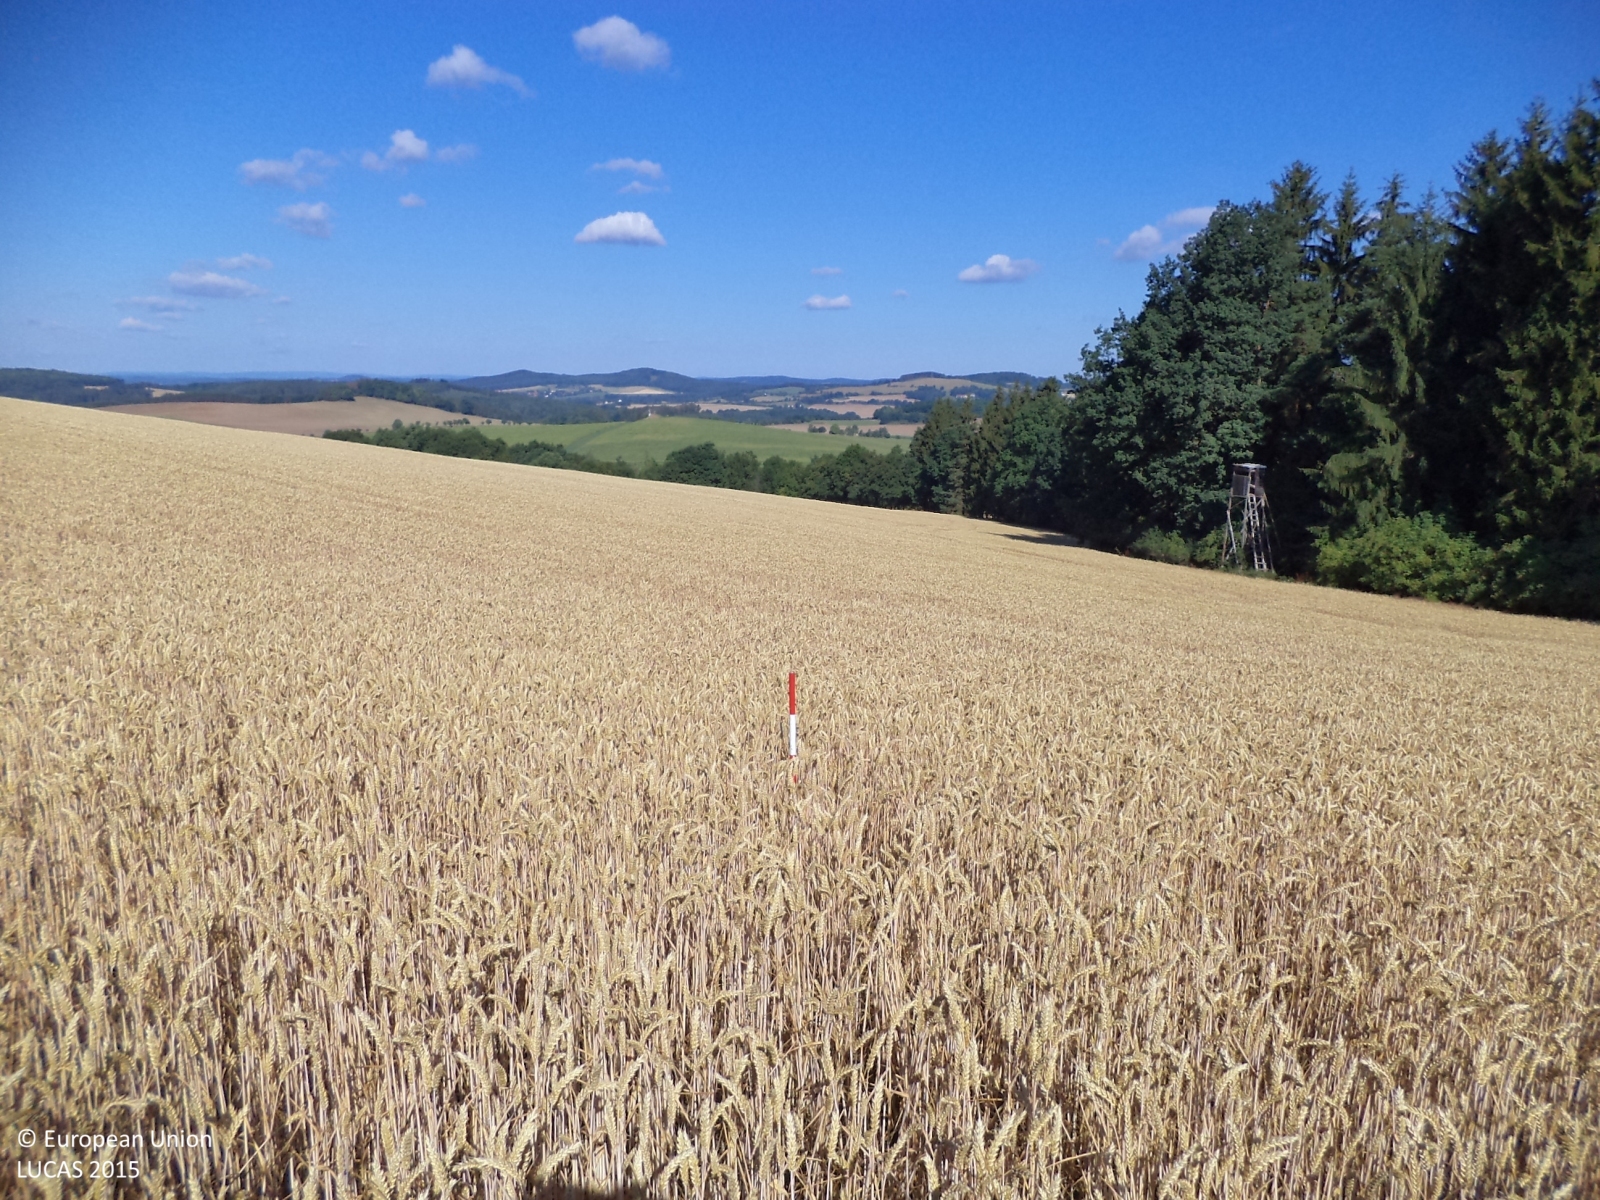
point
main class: Cropland
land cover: Common wheat
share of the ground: > 75 %
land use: Agriculture (excluding fallow land and kitchen gardens)
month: July
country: CZ
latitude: 49.7011
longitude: 14.4522
